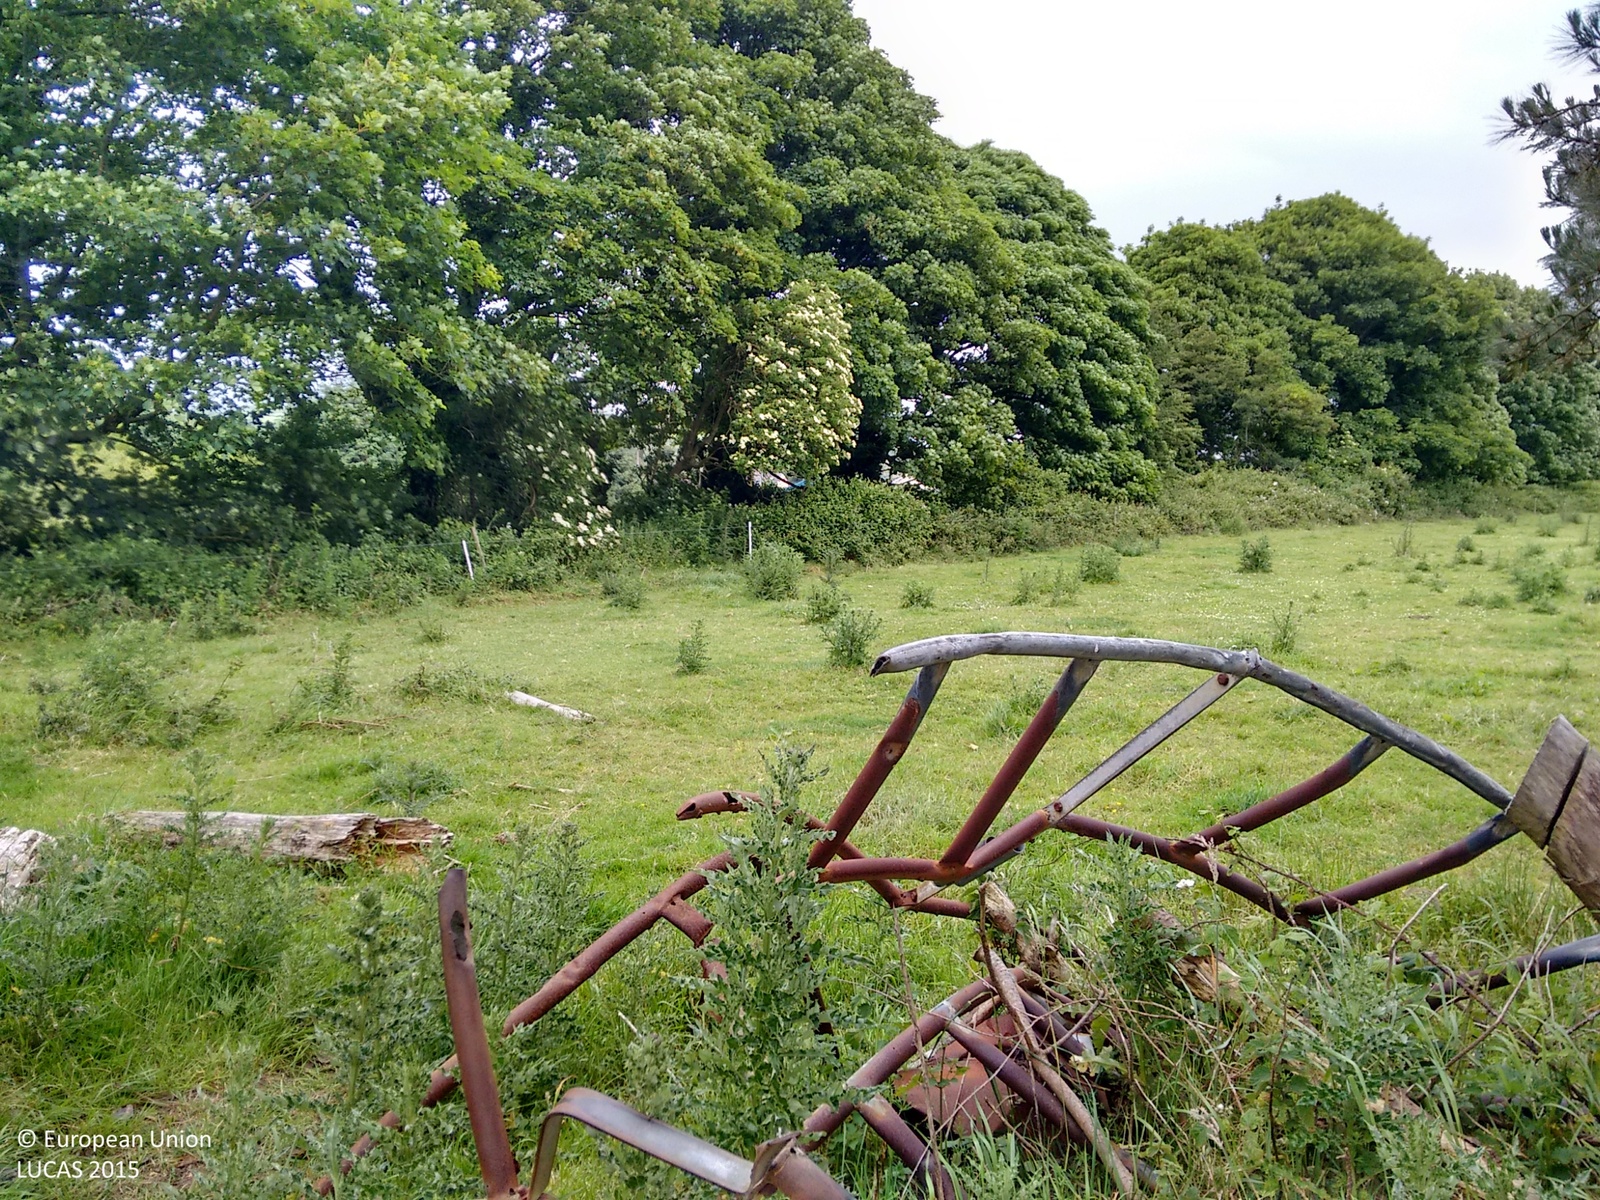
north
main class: Grassland
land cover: Grassland with sparse tree/shrub cover
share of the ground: > 75 %
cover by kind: herbaceous plants 95 %, coniferous forest trees 5 %
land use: Agriculture (excluding fallow land and kitchen gardens)
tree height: > 5 m
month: June
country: IE
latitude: 52.1904
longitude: -7.1001
